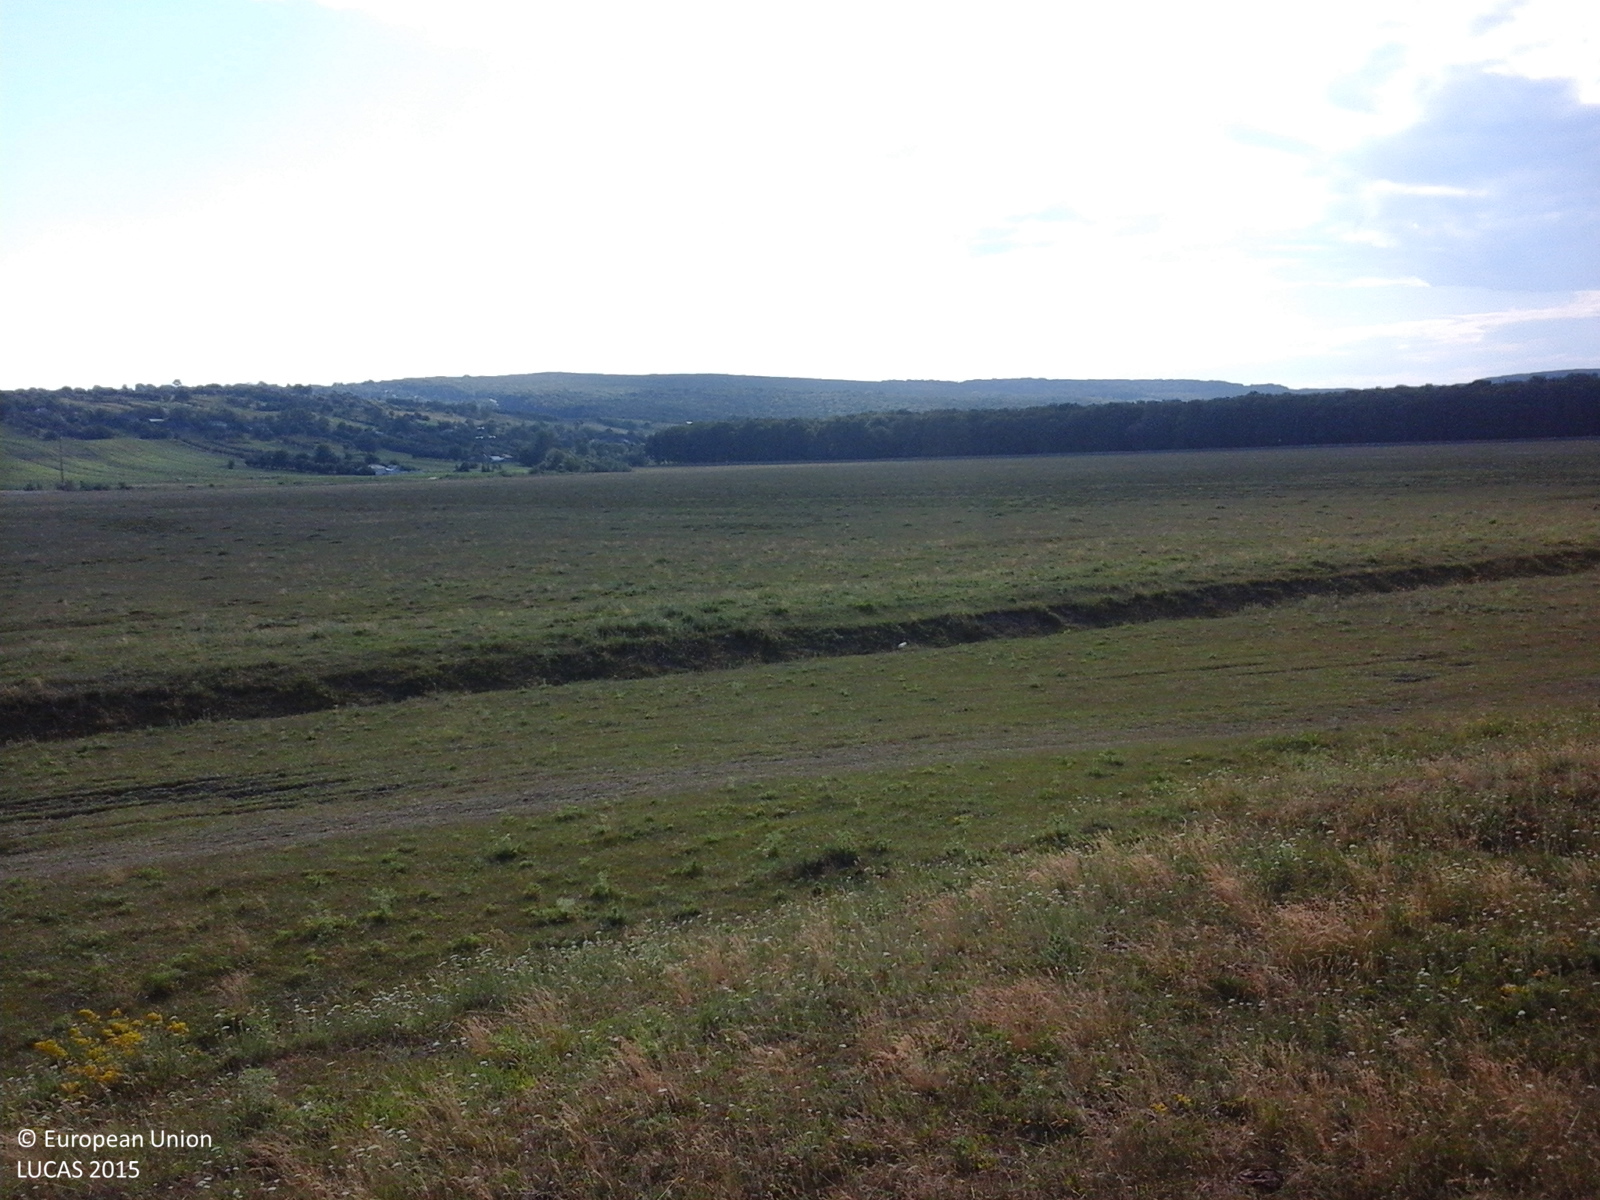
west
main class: Grassland
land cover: Grassland without tree/shrub cover
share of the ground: > 75 %
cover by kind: herbaceous plants 100 %
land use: Agriculture (excluding fallow land and kitchen gardens)
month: June
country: RO
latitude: 47.5870
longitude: 26.8949
